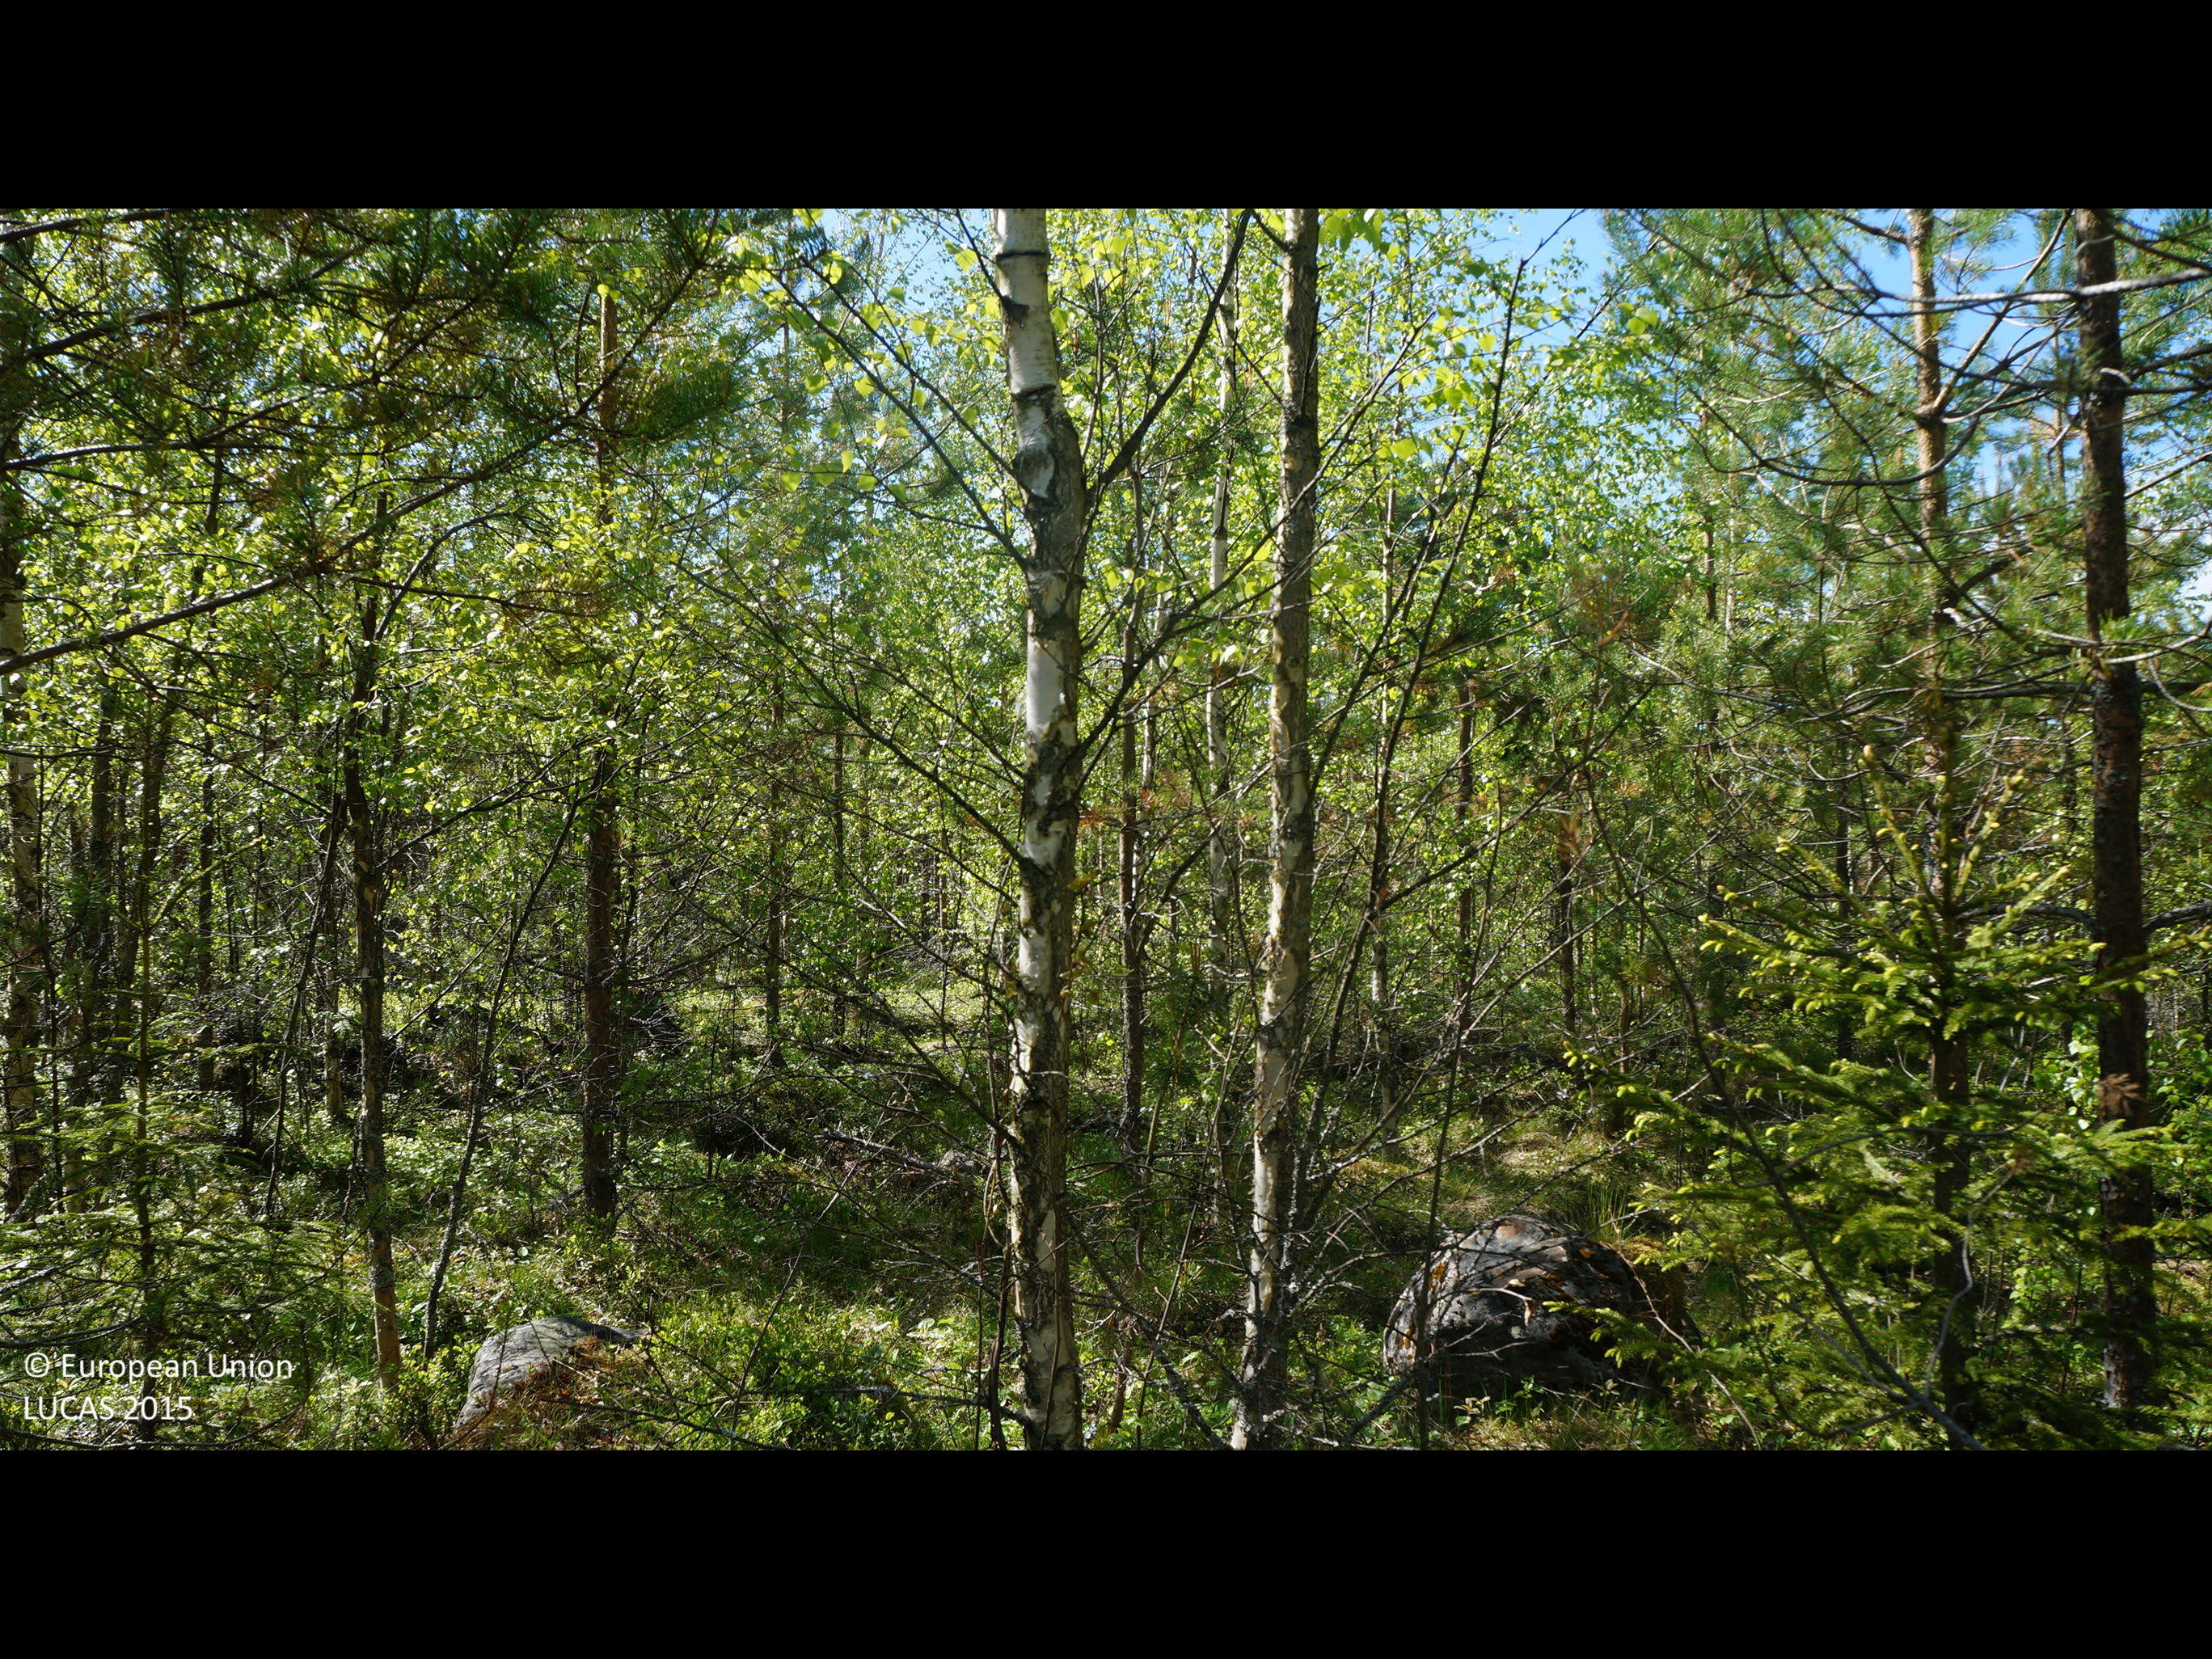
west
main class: Woodland
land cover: Other mixed woodland
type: boreal forest
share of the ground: > 75 %
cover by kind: coniferous forest trees 60 %, broadleaved forest trees 20 %, shrubs 20 %
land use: Forestry
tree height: > 5 m
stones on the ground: > 50 %
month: June
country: FI
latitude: 63.7413
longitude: 23.3264
